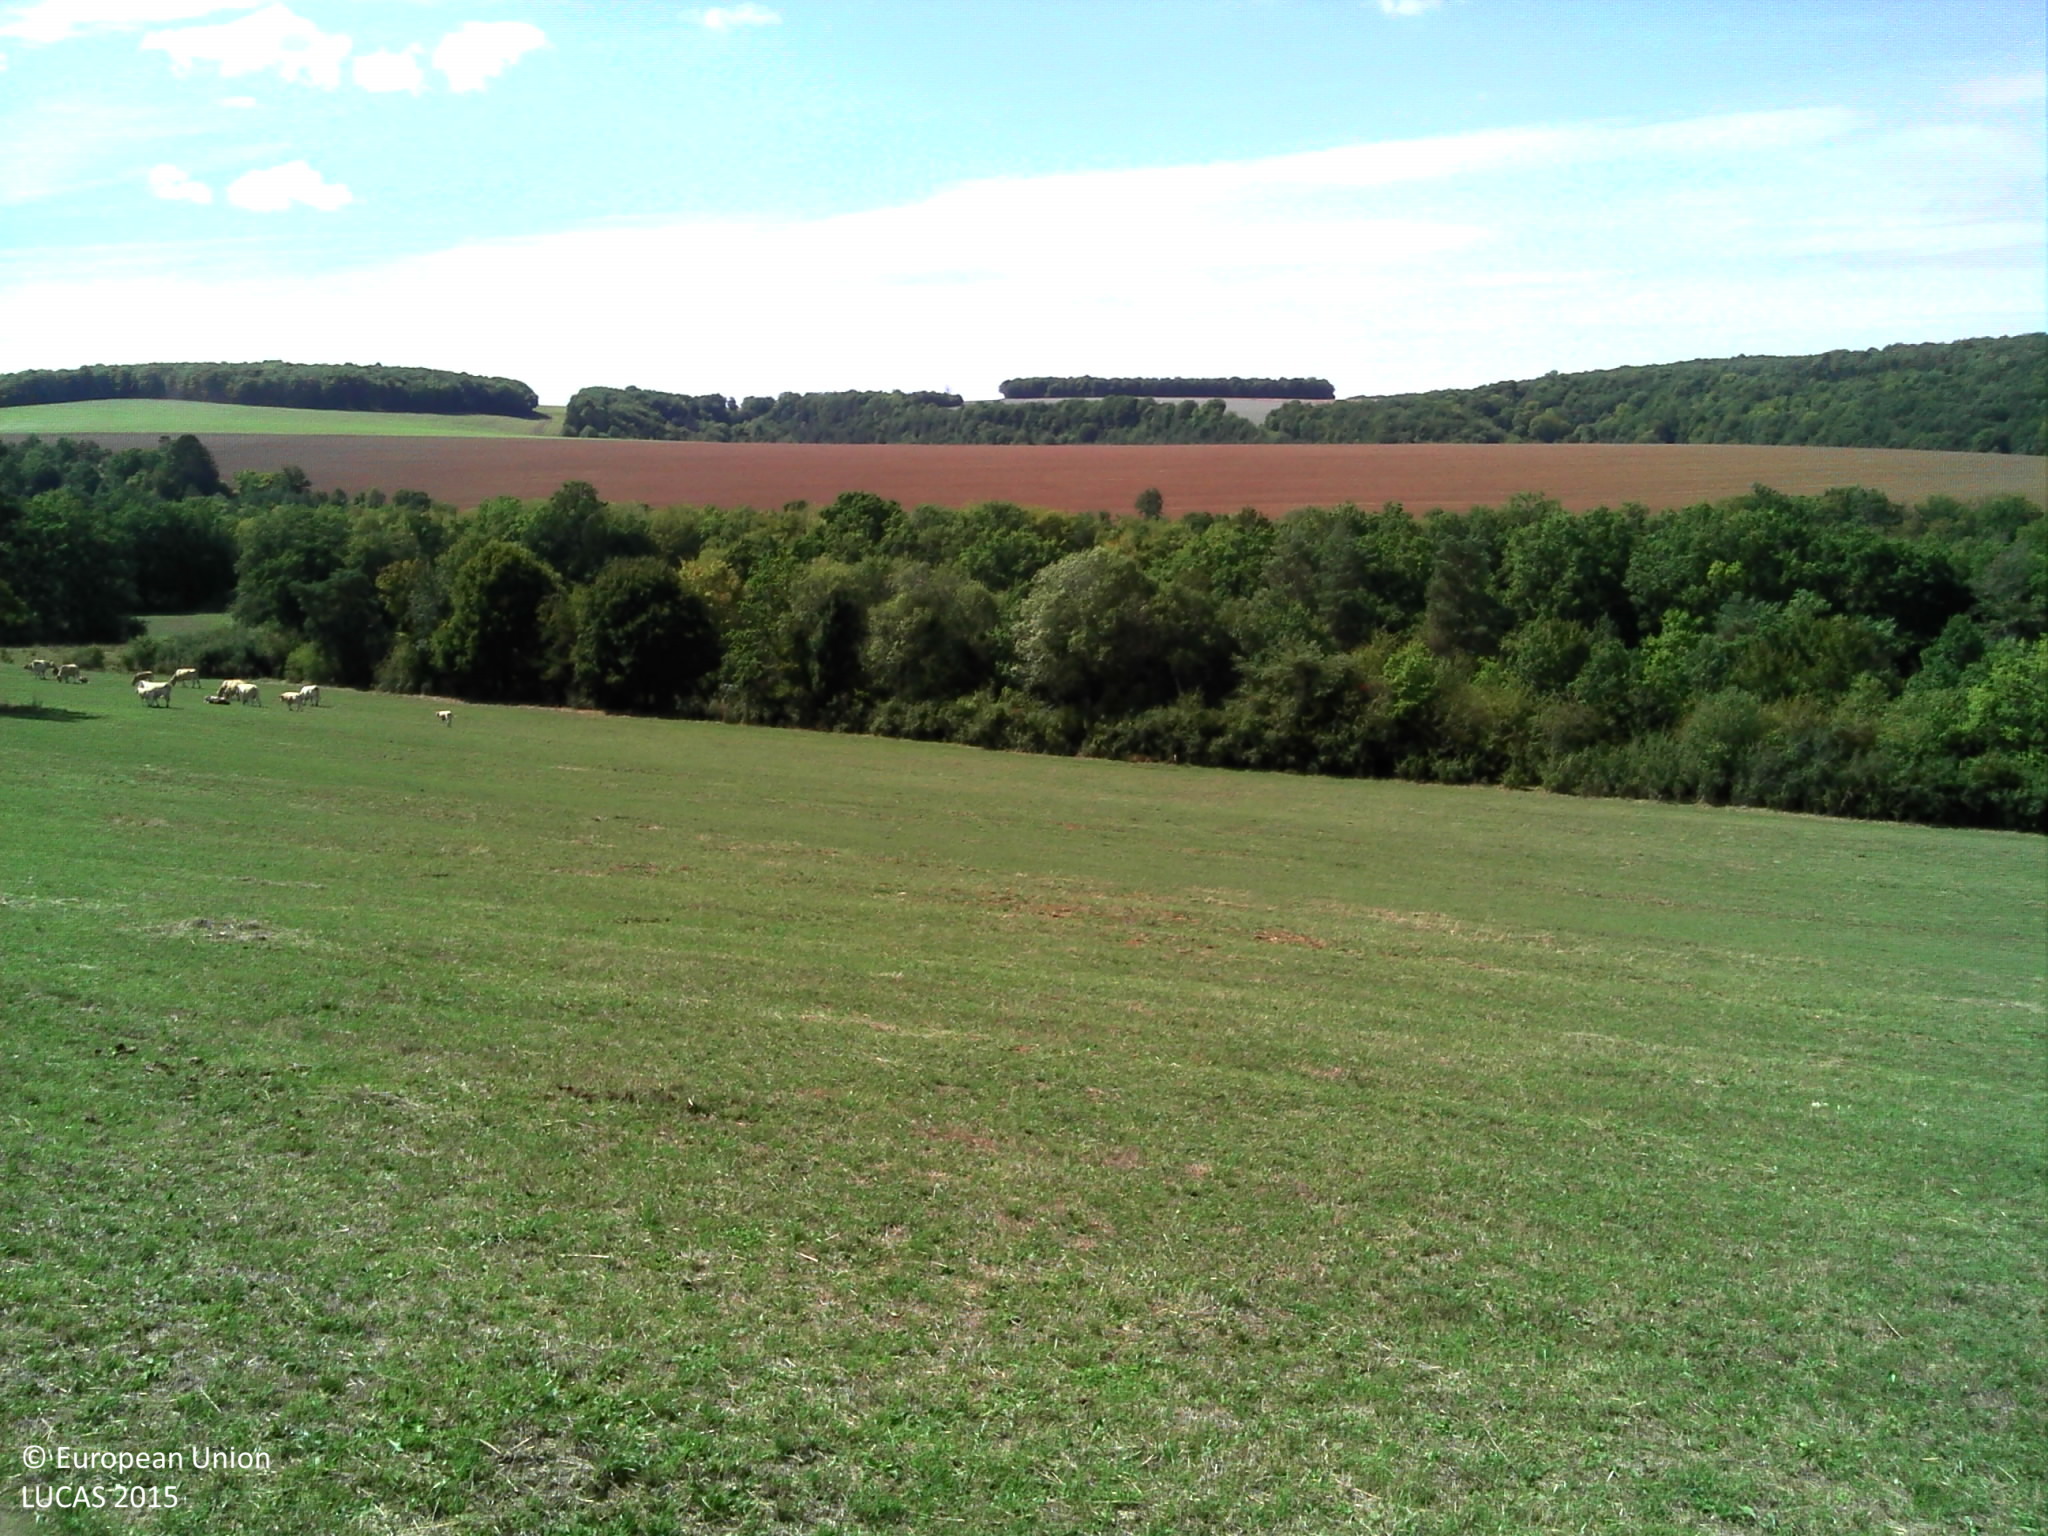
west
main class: Grassland
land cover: Grassland without tree/shrub cover
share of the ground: > 75 %
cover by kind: herbaceous plants 100 %
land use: Agriculture (excluding fallow land and kitchen gardens)
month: August
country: FR
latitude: 47.7470
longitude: 4.9445
